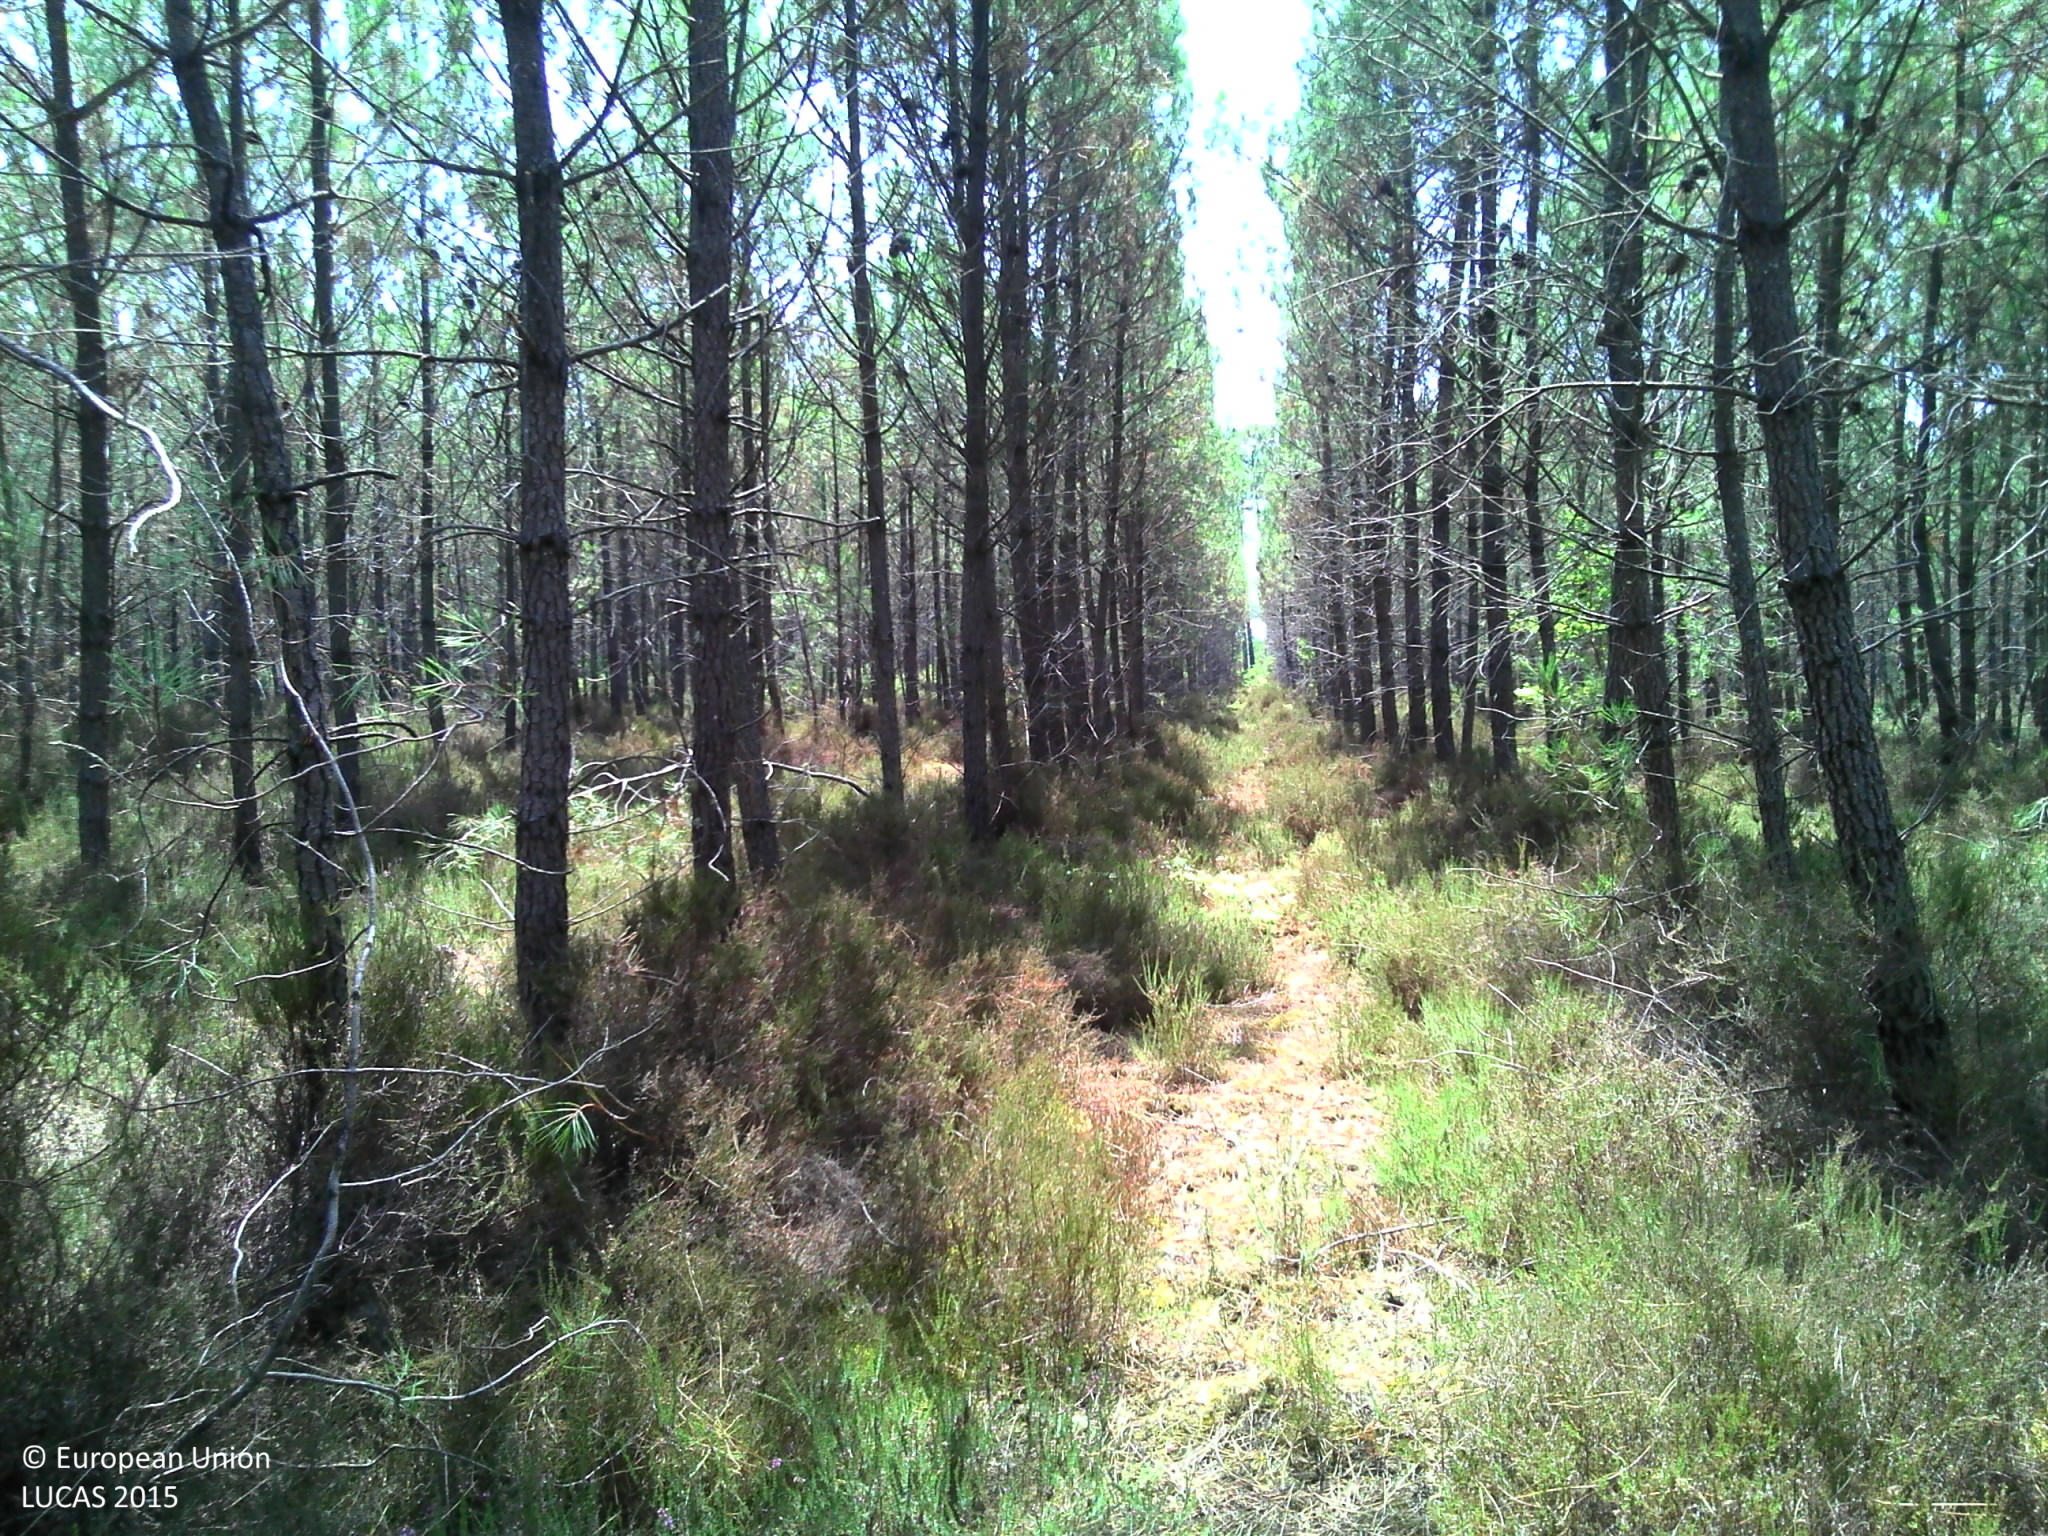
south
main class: Woodland
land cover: Pine dominated coniferous woodland
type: coniferous forest of the mediterranean region
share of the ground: > 75 %
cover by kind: coniferous forest trees 75 %, herbaceous plants 20 %, lichens and mosses 5 %
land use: Forestry
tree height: > 5 m
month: August
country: FR
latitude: 44.1577
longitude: -1.0599
